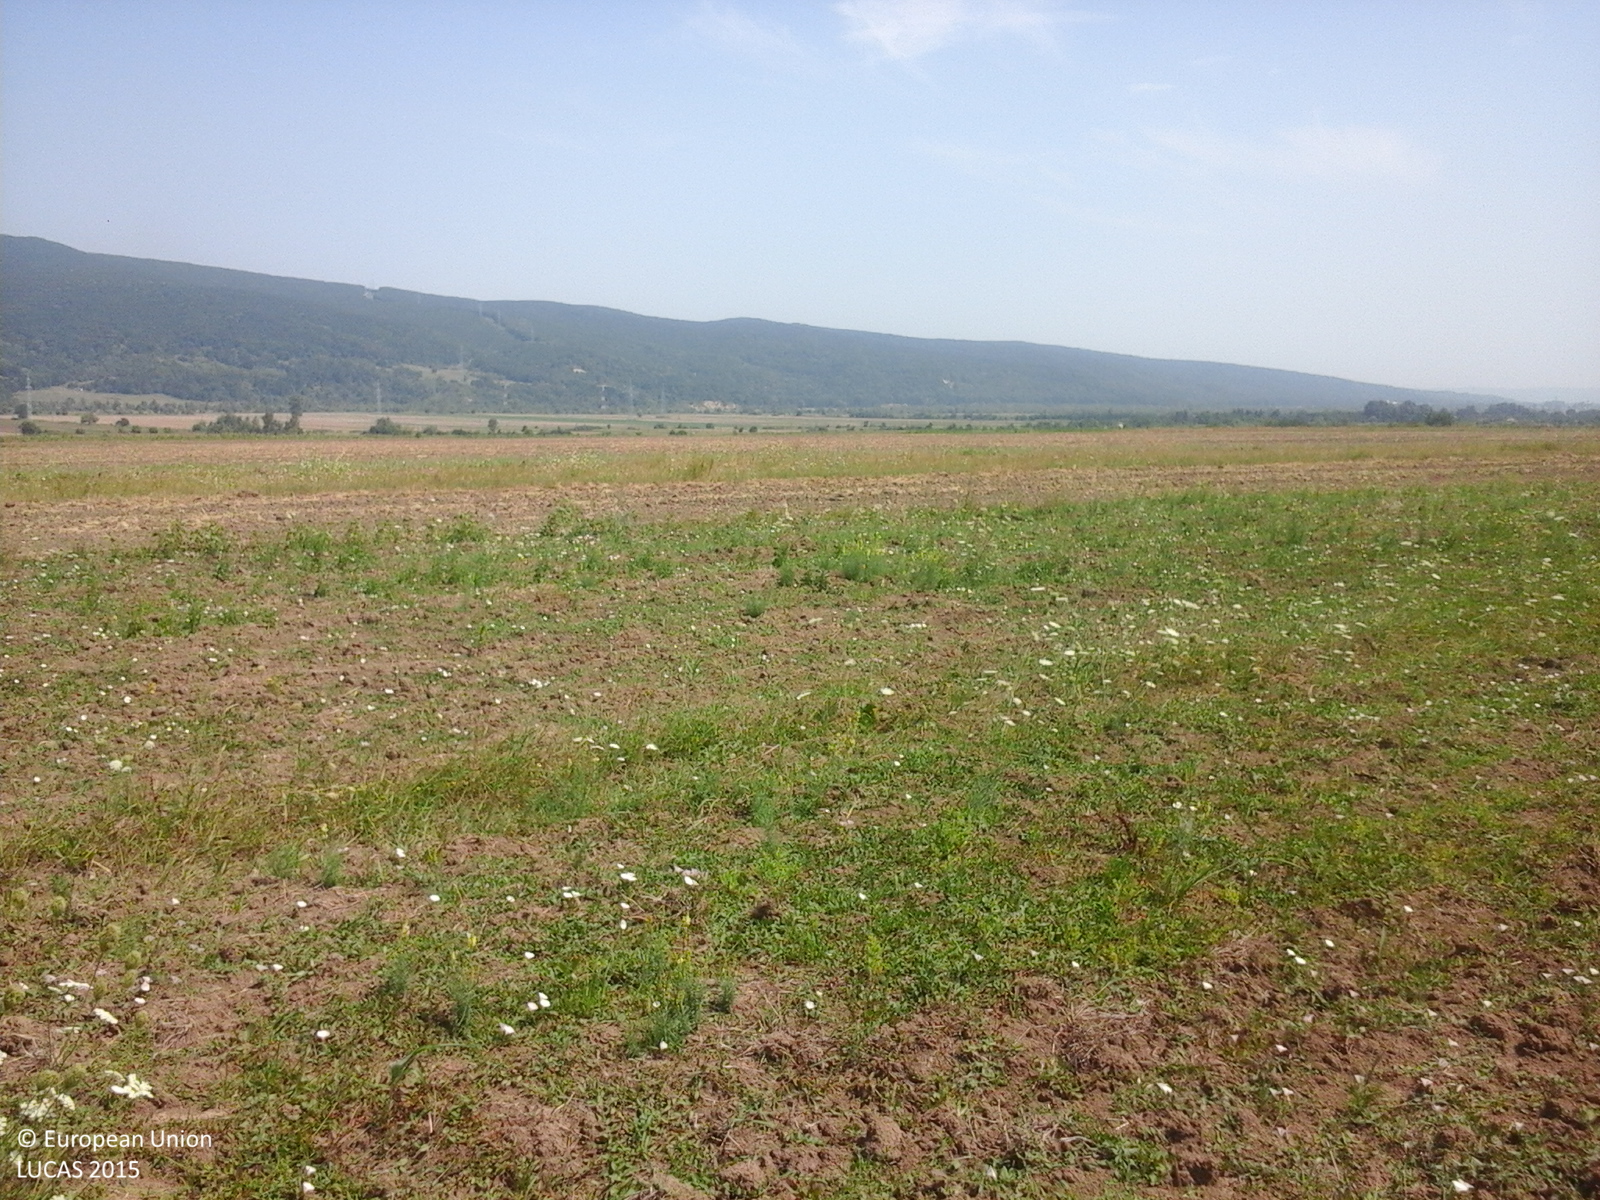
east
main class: Grassland
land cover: Spontaneously vegetated surfaces
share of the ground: 10 - 25 %
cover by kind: herbaceous plants 100 %
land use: Fallow land
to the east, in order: Spontaneously vegetated surfaces; Grassland without tree/shrub cover; Tracks; Grassland without tree/shrub cover; Rye; Common wheat
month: August
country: RO
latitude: 46.1600
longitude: 26.9659
